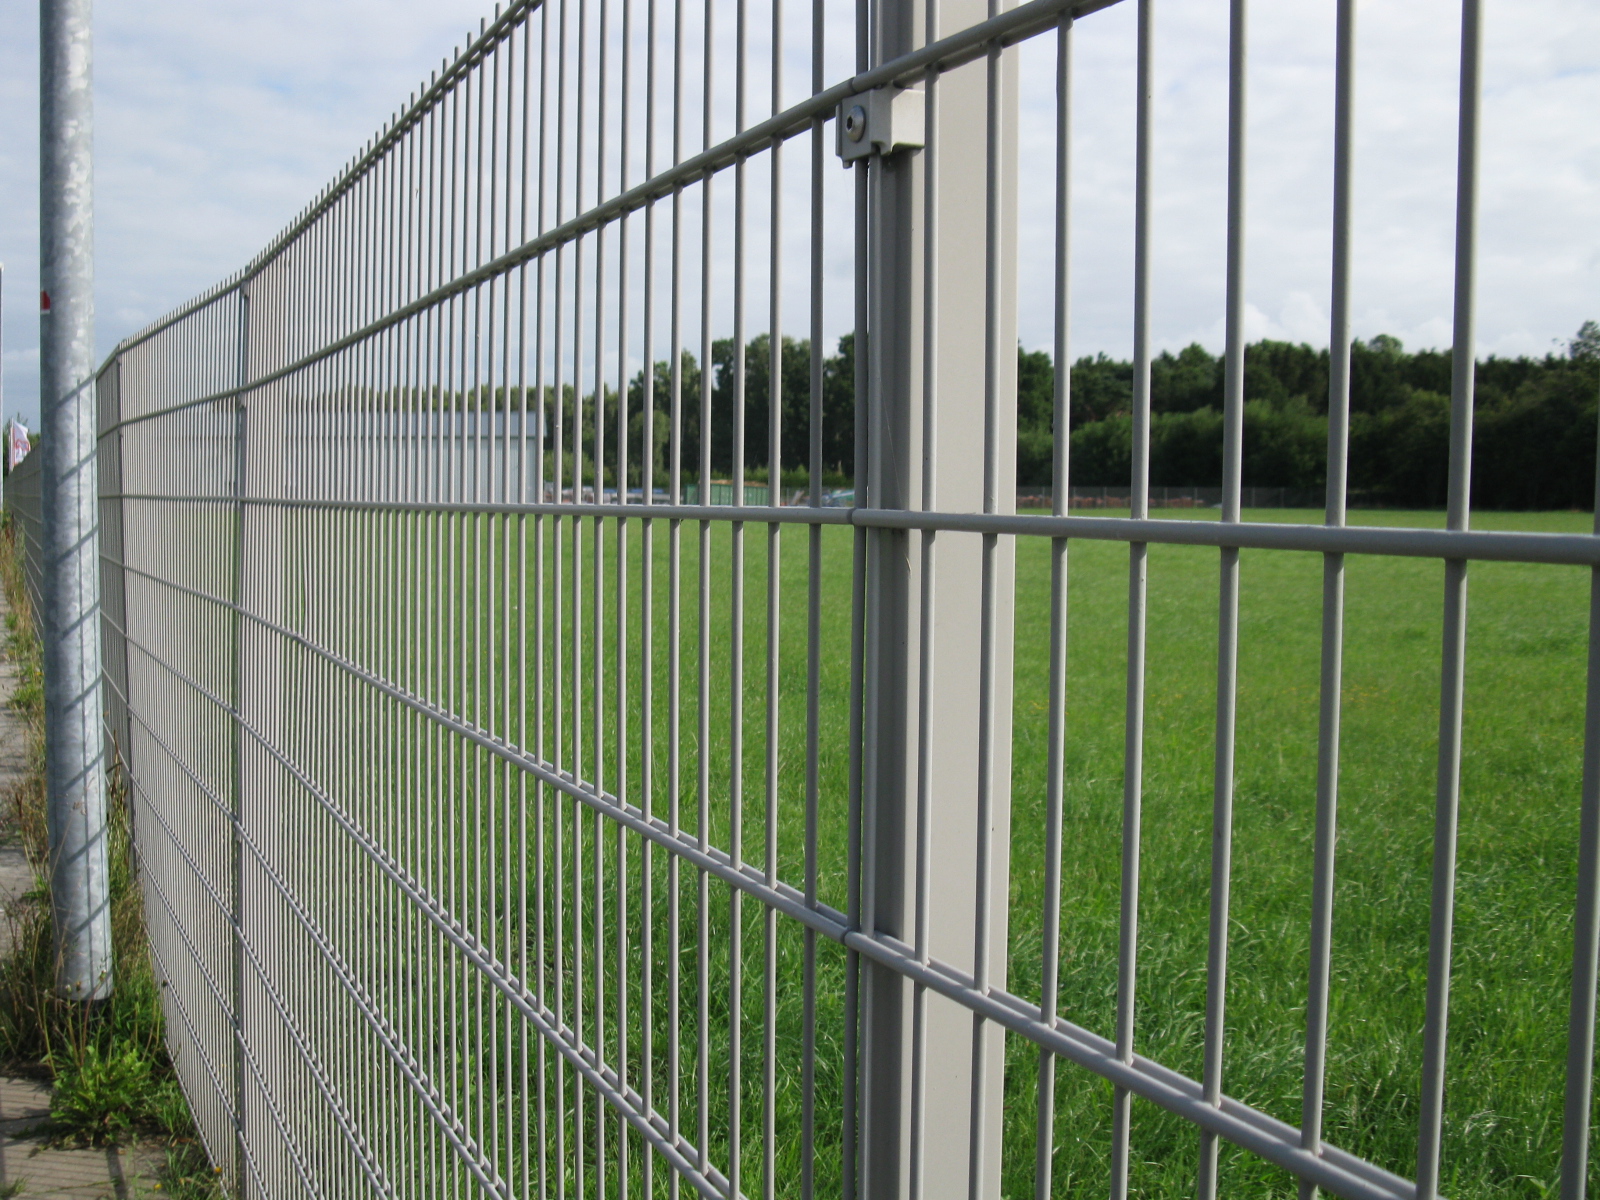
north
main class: Grassland
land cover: Grassland without tree/shrub cover
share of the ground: > 75 %
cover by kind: herbaceous plants 100 %
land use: Agriculture (excluding fallow land and kitchen gardens)
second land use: Commerce
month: July
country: DE
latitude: 53.0334
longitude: 8.5242
